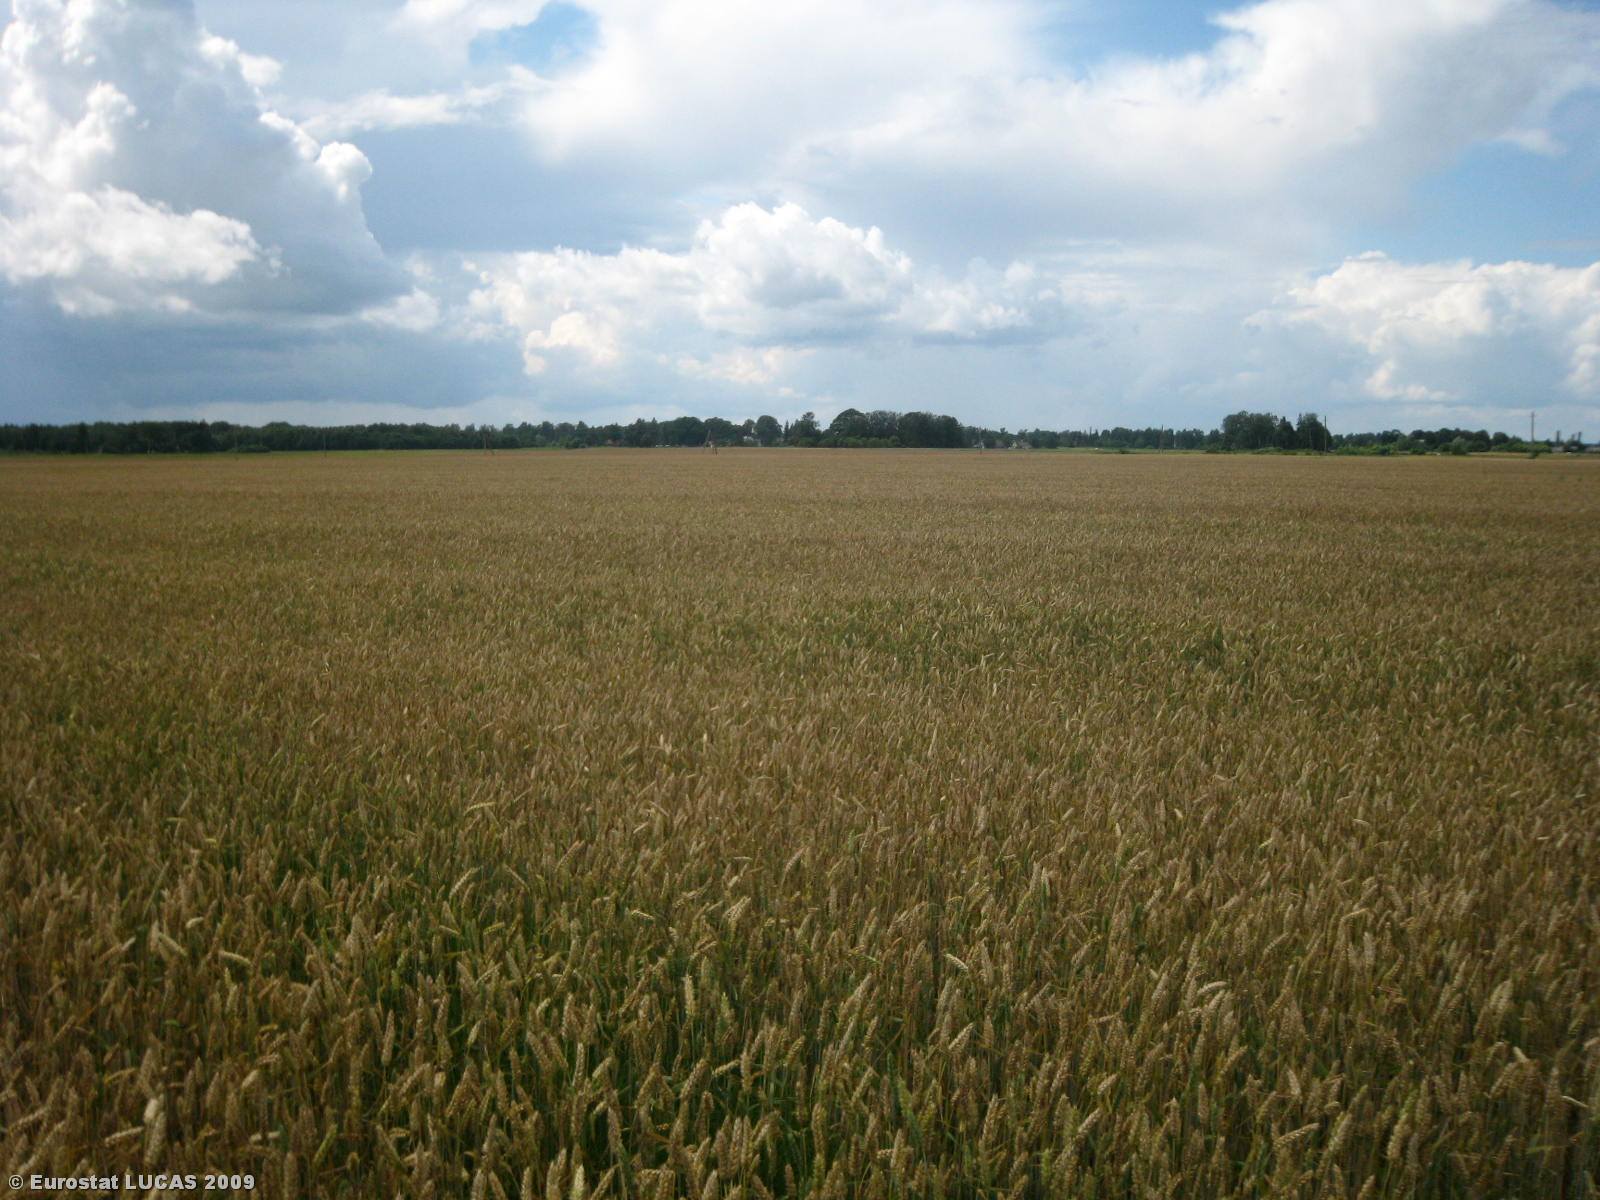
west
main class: Cropland
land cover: Common wheat
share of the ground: > 75 %
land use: Agriculture (excluding fallow land and kitchen gardens)
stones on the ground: < 10 %
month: July
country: LT
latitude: 55.6322
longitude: 24.0194
